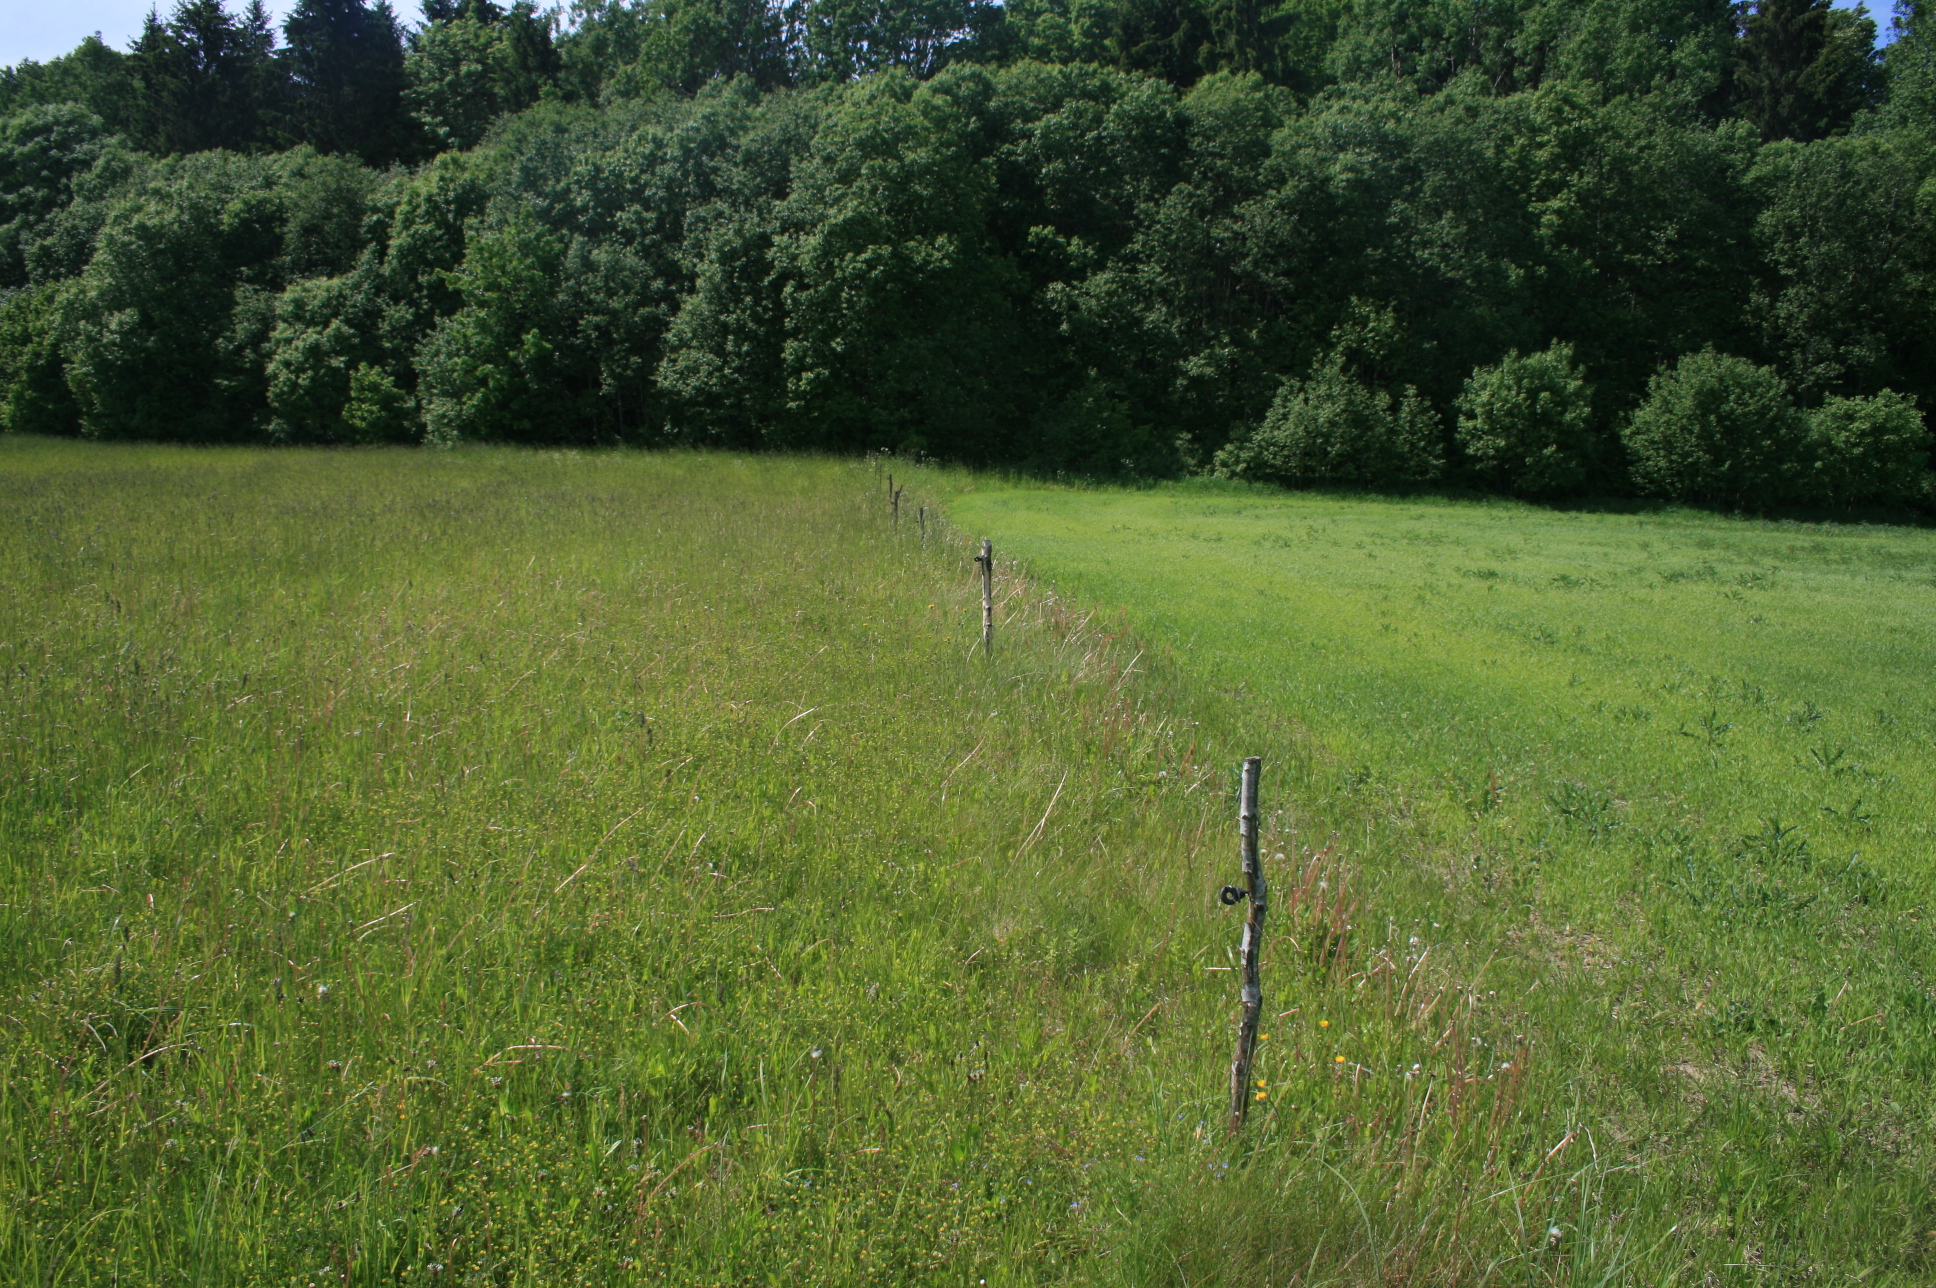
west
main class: Grassland
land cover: Grassland without tree/shrub cover
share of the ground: > 75 %
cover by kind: herbaceous plants 100 %
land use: Agriculture (excluding fallow land and kitchen gardens)
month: June
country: LT
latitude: 55.9297
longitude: 22.3982
